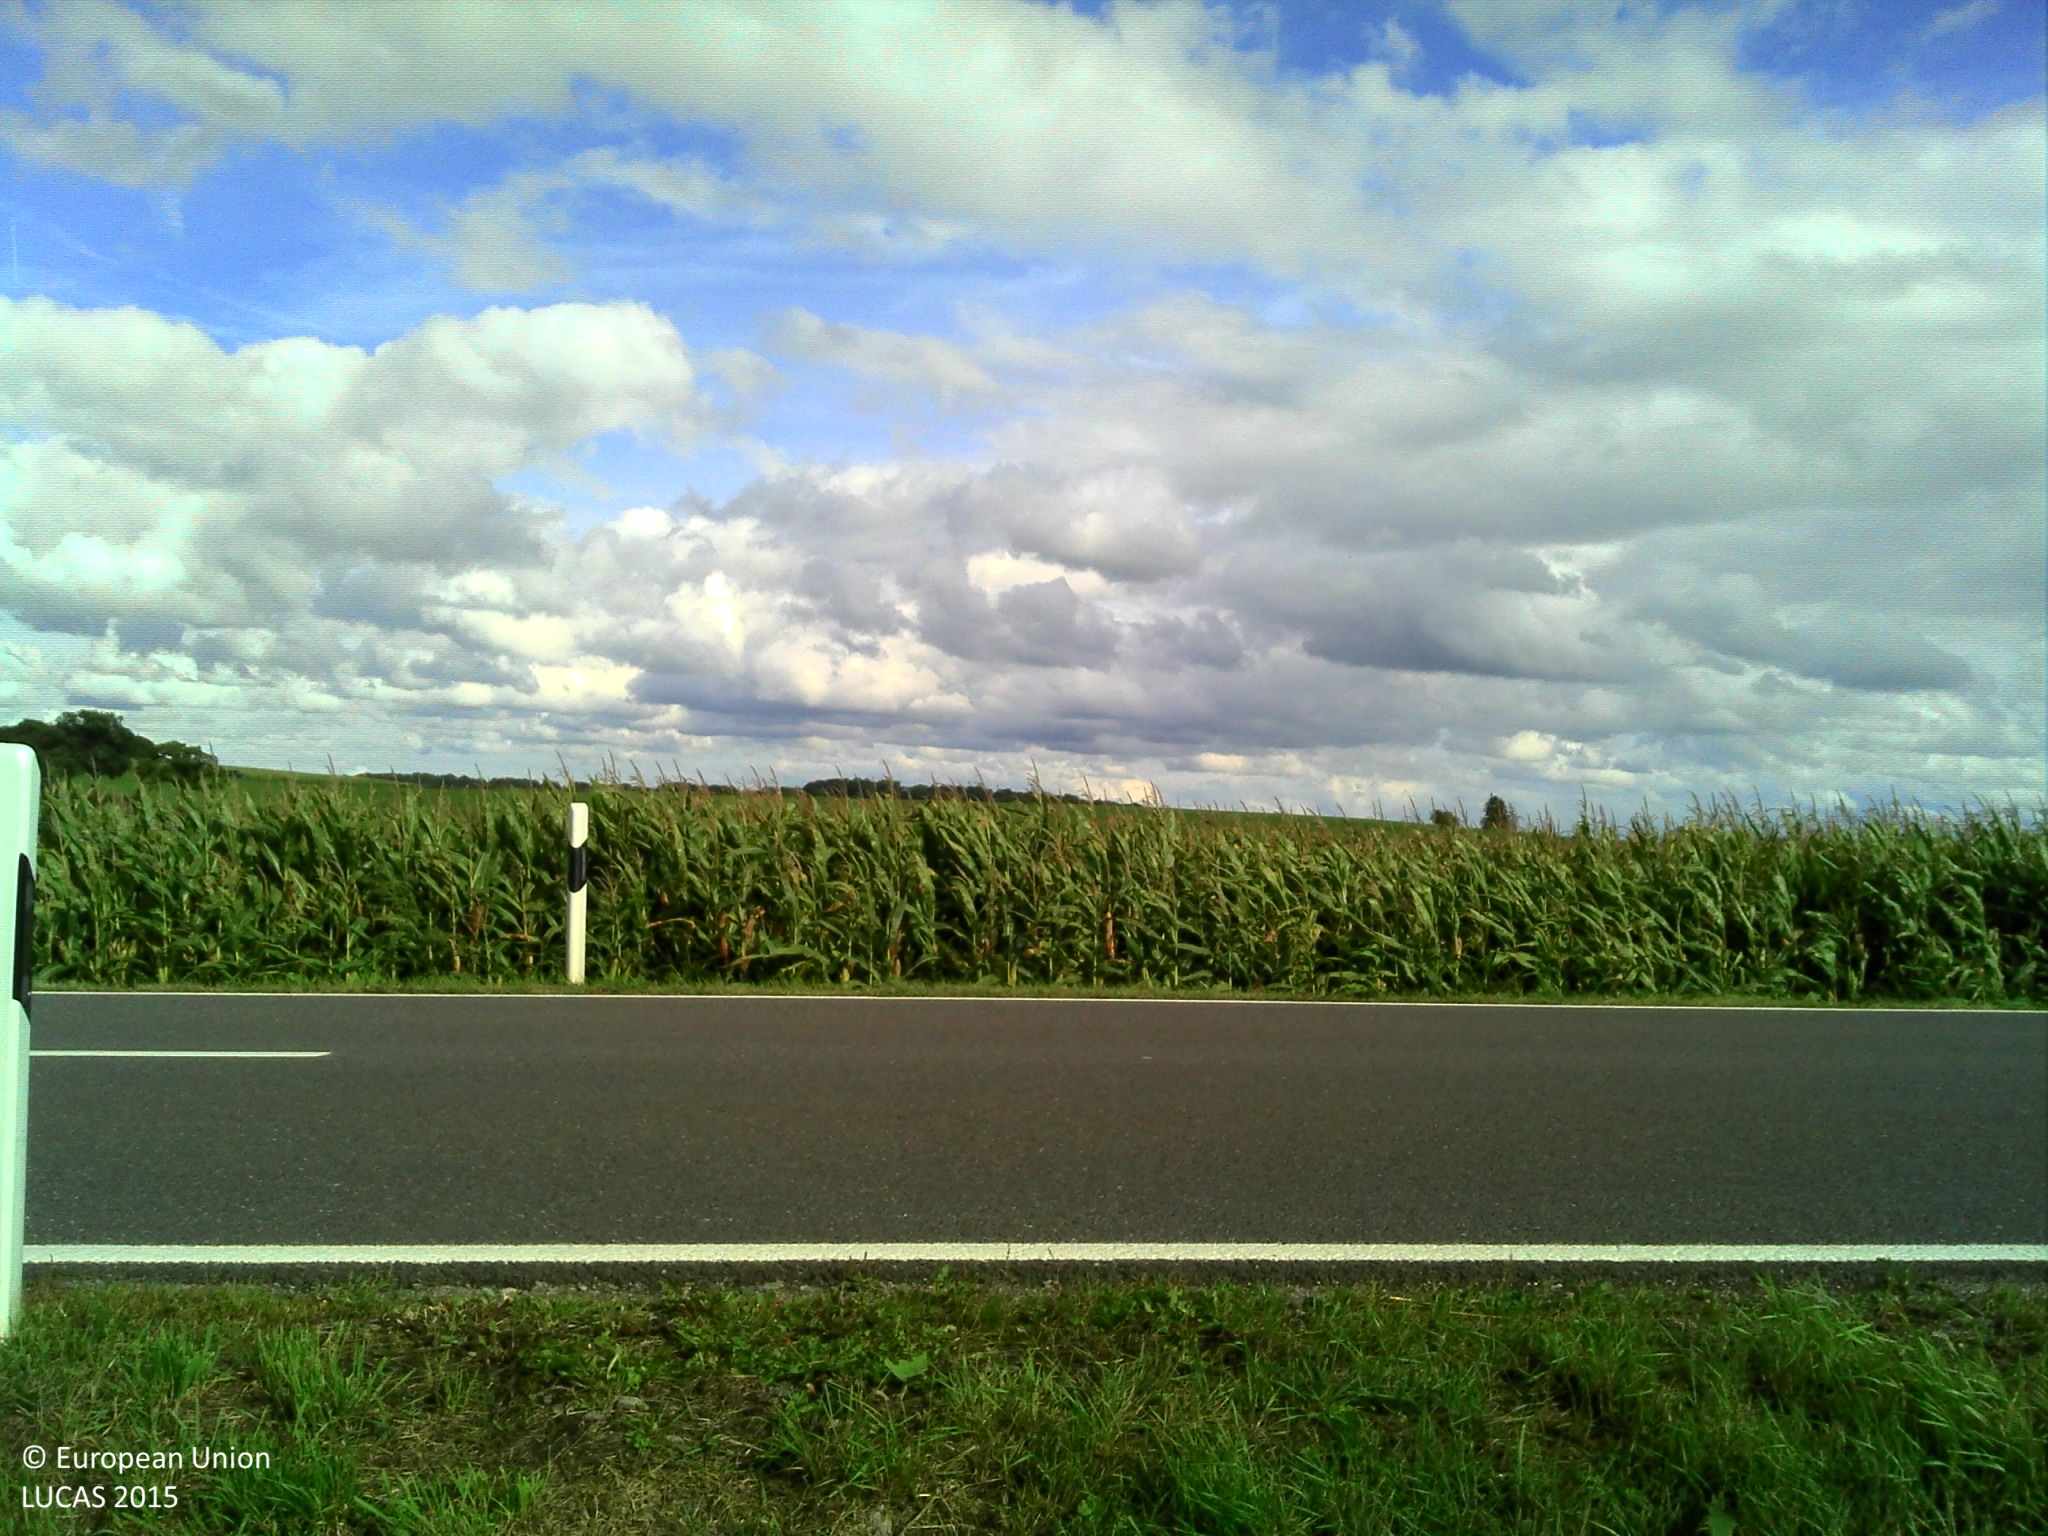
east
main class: Grassland
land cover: Grassland without tree/shrub cover
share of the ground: > 75 %
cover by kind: herbaceous plants 100 %
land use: Agriculture (excluding fallow land and kitchen gardens)
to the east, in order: Grassland without tree/shrub cover; Paved roads, cycling and walking lanes; Grass margins; Maize; Spontaneously vegetated surfaces; Grassland without tree/shrub cover; Other leguminous and mixtures for fodder
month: September
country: LU
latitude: 49.7872
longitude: 6.4578
